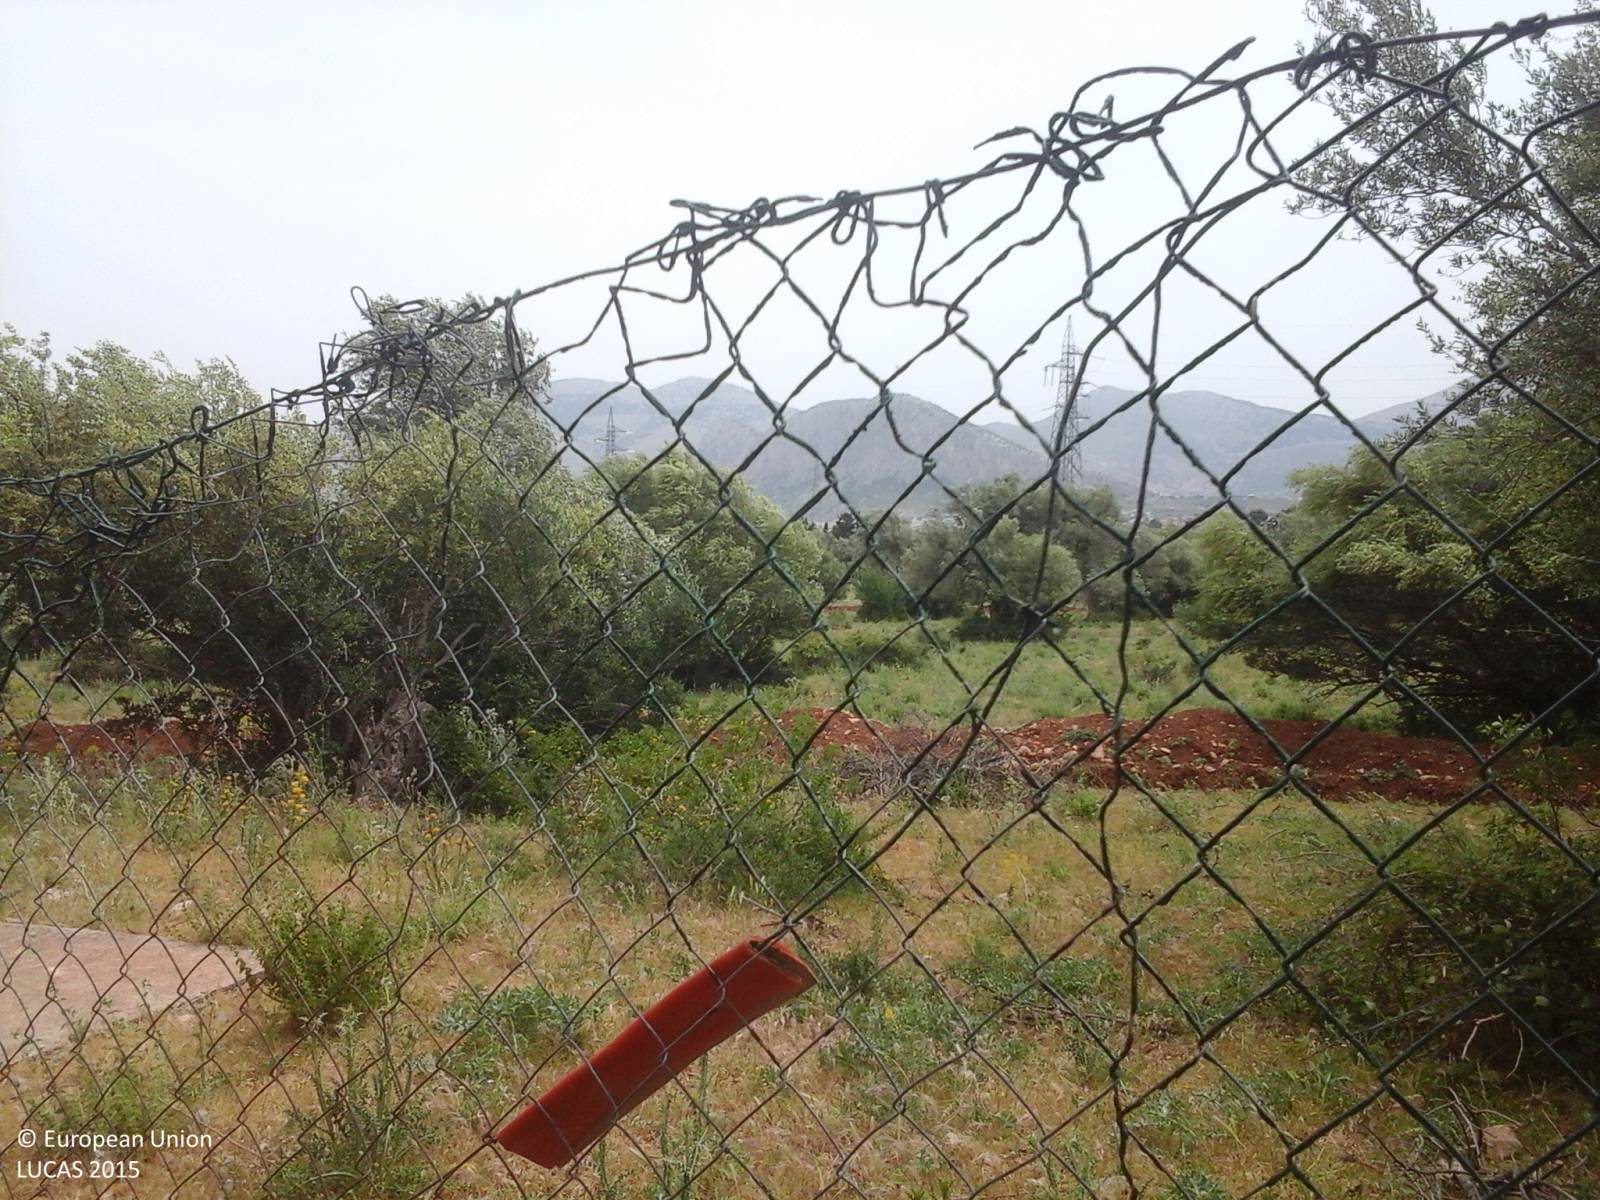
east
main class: Cropland
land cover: Olive groves
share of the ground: 25 - 50 %
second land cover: Spontaneously vegetated surfaces
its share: > 75 %
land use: Agriculture (excluding fallow land and kitchen gardens)
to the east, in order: Olive groves; Spontaneously vegetated surfaces; Managed hedges; Spontaneously vegetated surfaces; Managed hedges; Olive groves; Grassland without tree/shrub cover
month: May
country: IT
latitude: 38.1490
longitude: 13.1616
